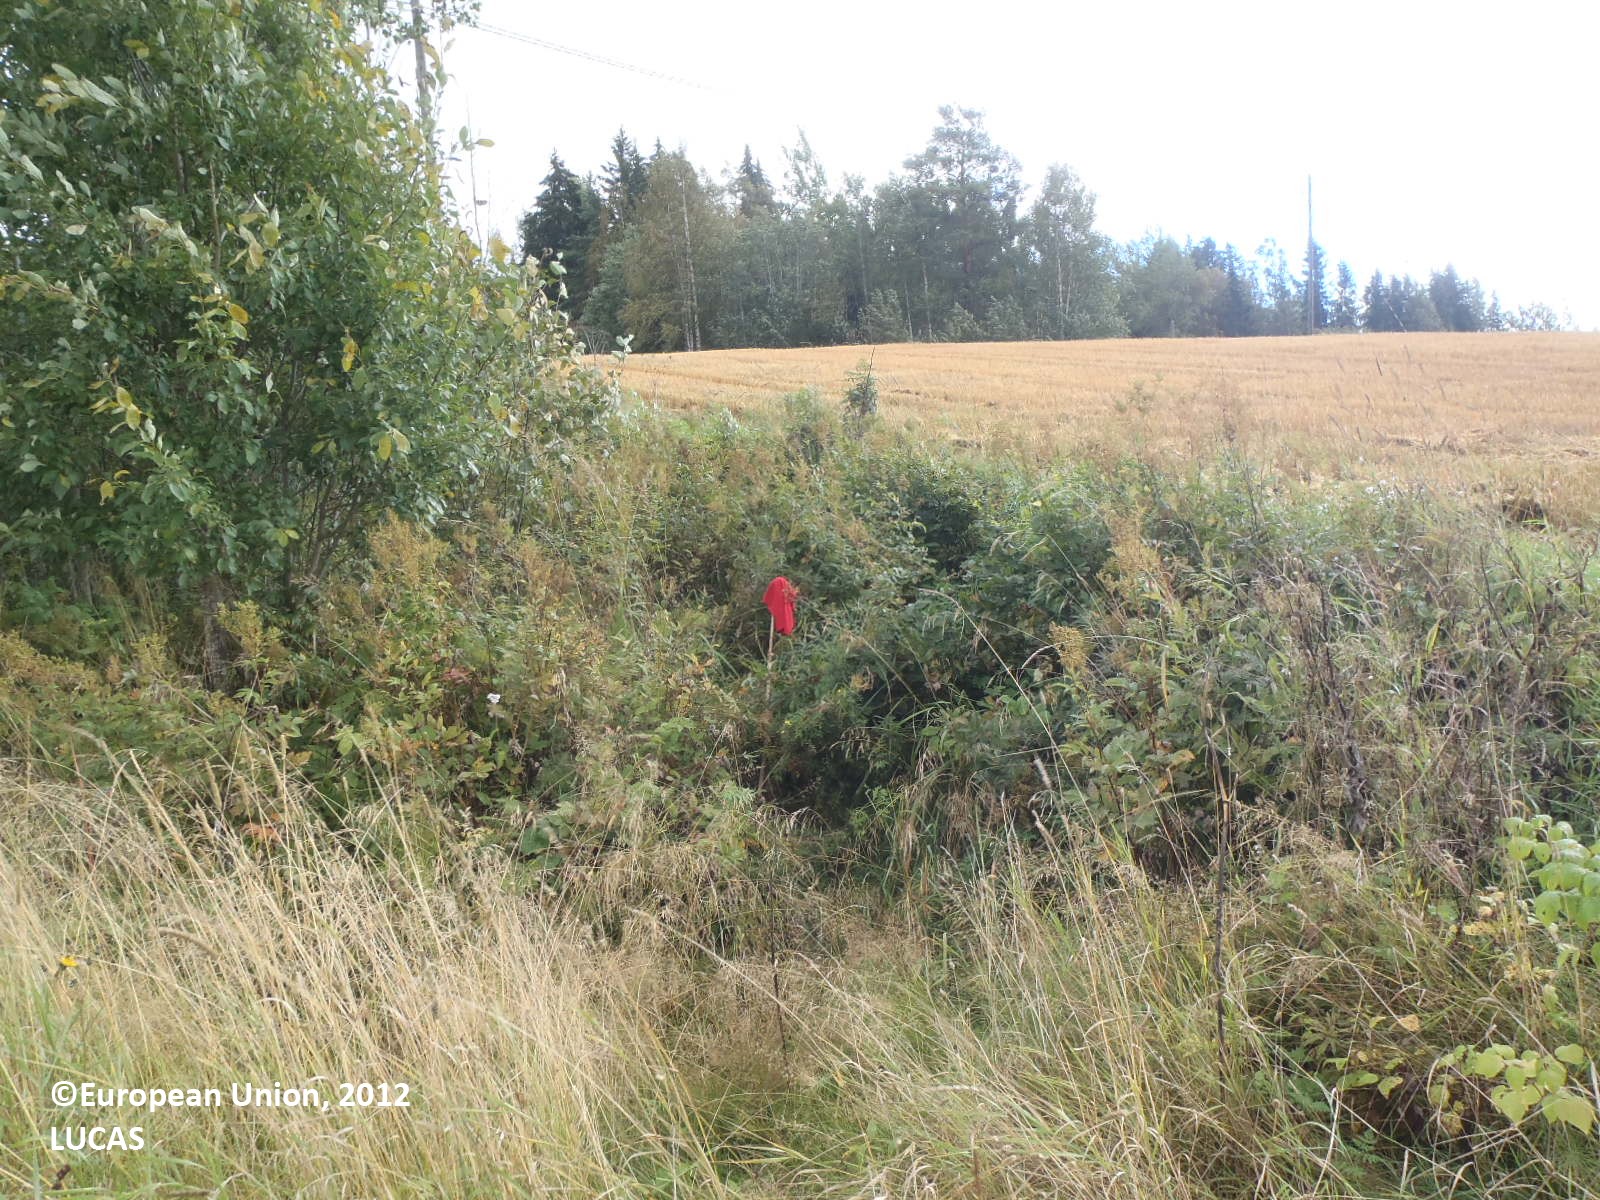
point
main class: Woodland
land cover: Broadleaved woodland
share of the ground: 50 - 75 %
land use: Forestry
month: September
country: FI
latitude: 61.6450
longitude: 22.7690
